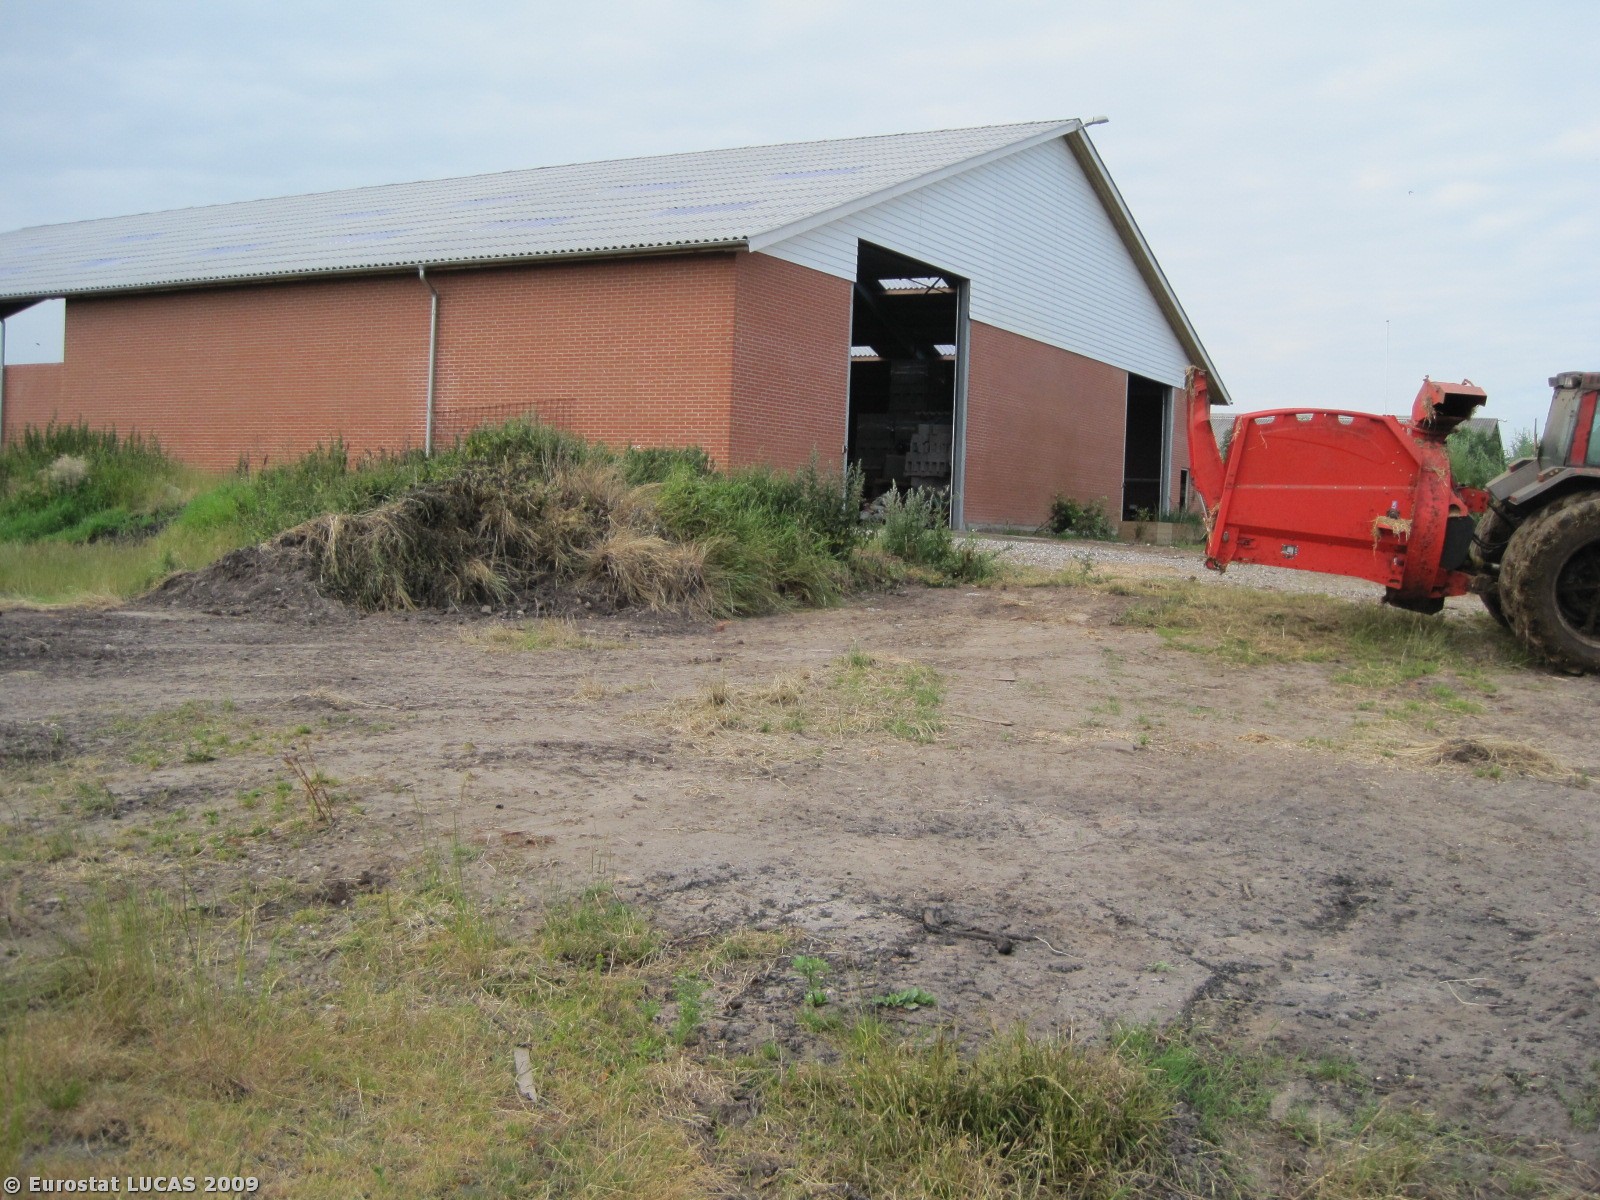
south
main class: Grassland
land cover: Grassland without tree/shrub cover
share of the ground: > 75 %
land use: Agriculture (excluding fallow land and kitchen gardens)
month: June
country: DK
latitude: 56.5385
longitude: 8.4895
